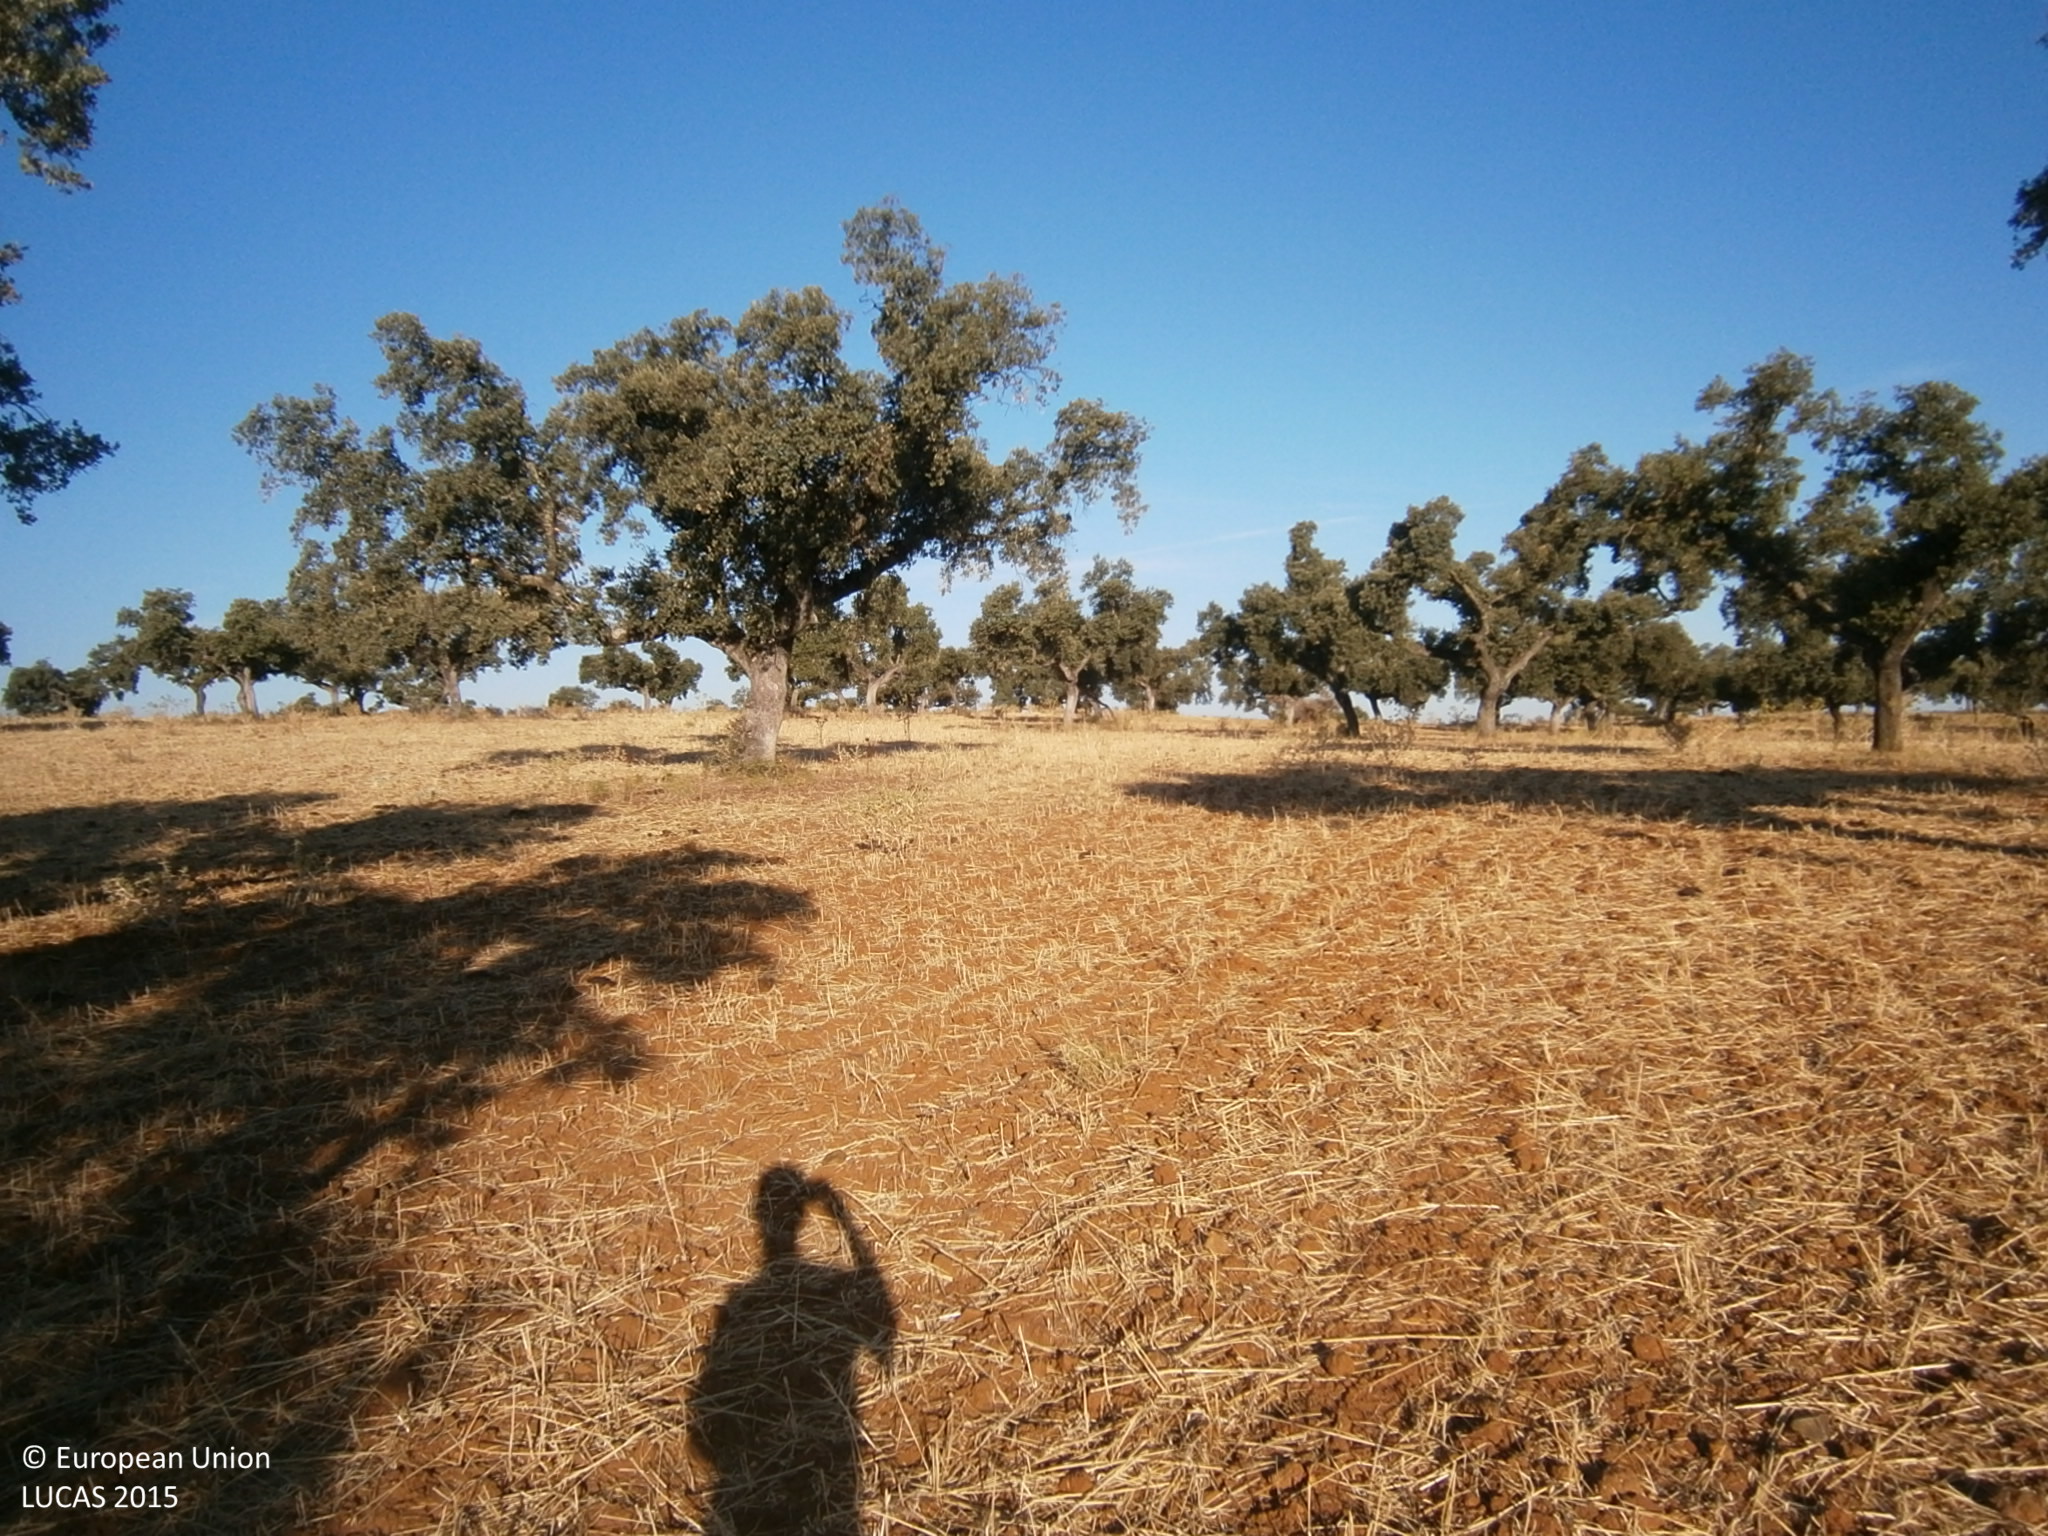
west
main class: Woodland
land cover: Broadleaved woodland
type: broadleaved evergreen forest
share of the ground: 50 - 75 %
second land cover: Spontaneously vegetated surfaces
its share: 50 - 75 %
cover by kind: broadleaved forest trees 45 %, herbaceous plants 45 %, shrubs 5 %, unconsolidated bare surface 5 %
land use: Forestry
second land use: Agriculture (excluding fallow land and kitchen gardens)
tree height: > 5 m
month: June
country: ES
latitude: 38.8449
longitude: -6.4773
